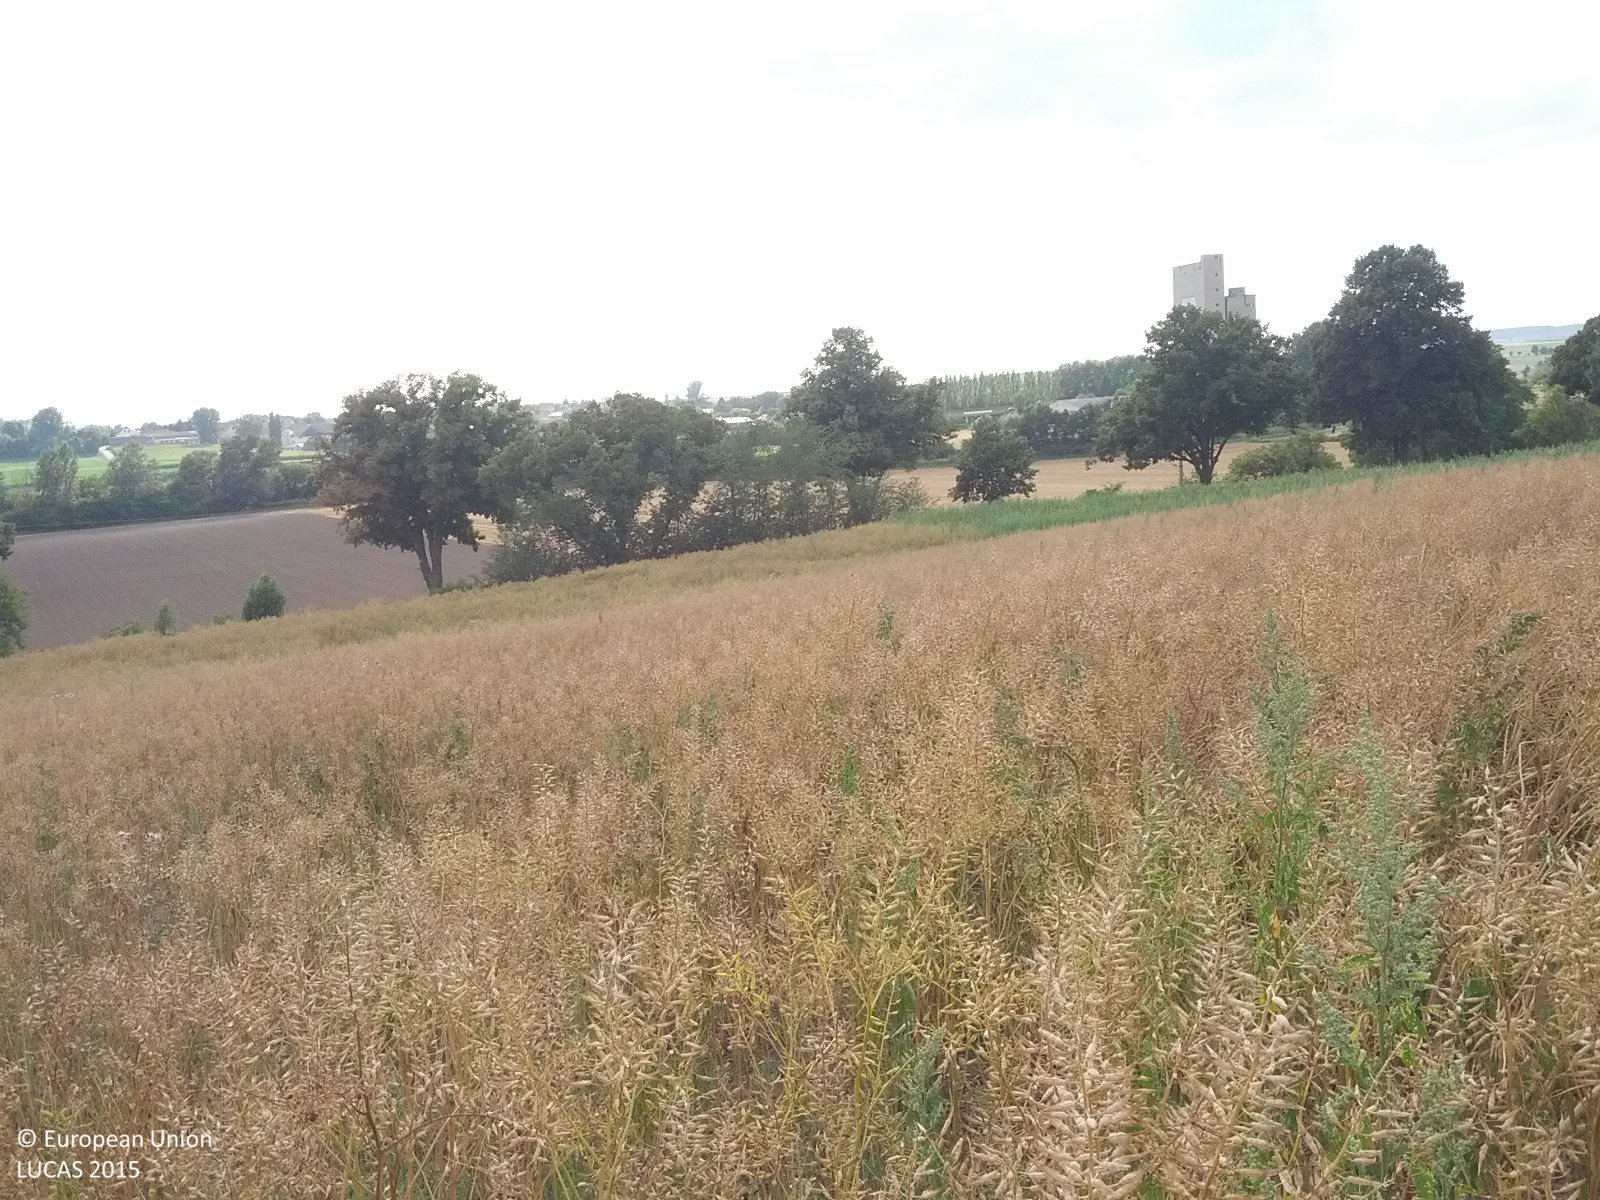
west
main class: Cropland
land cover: Other fibre and oleaginous crops
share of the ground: > 75 %
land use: Agriculture (excluding fallow land and kitchen gardens)
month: July
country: AT
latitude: 48.4111
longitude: 16.1788
